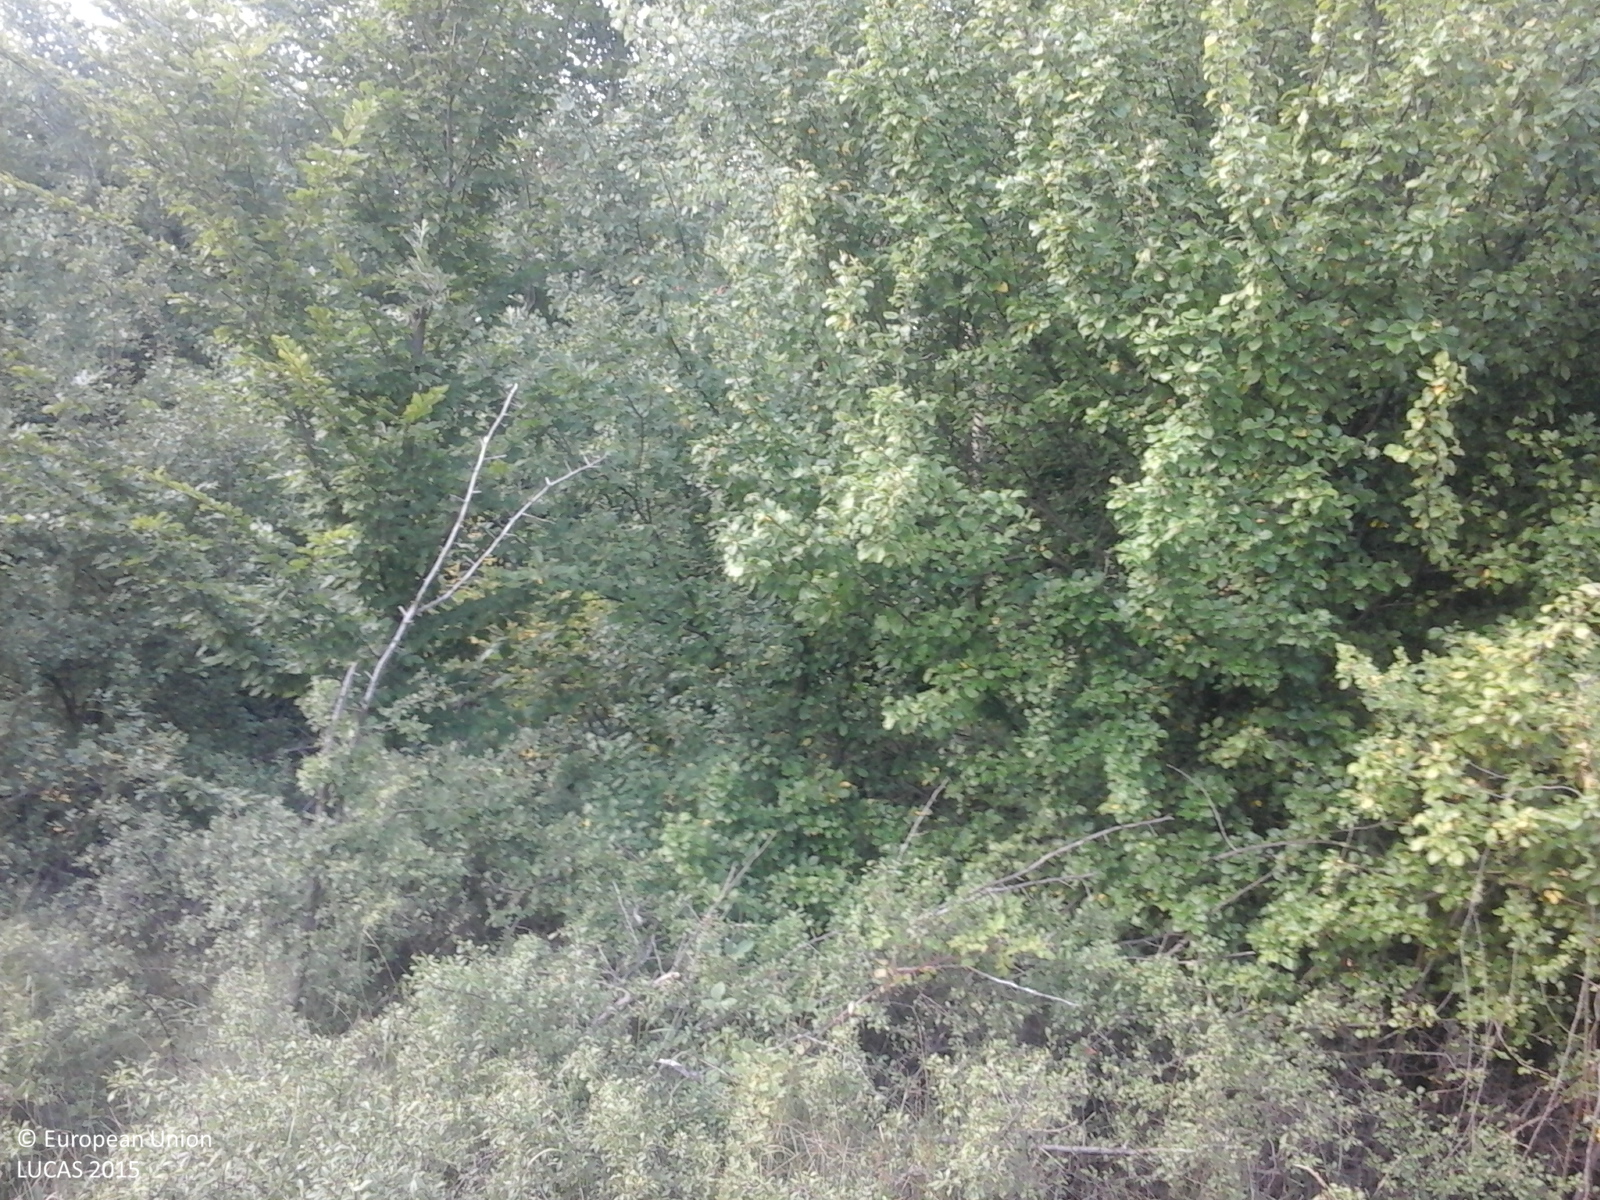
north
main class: Shrubland
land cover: Shrubland with sparse tree cover
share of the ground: > 75 %
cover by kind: shrubs 85 %, herbaceous plants 10 %, broadleaved forest trees 5 %
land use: Semi-natural and natural areas not in use
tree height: < 5 m
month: July
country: RO
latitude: 45.0338
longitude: 24.7154
